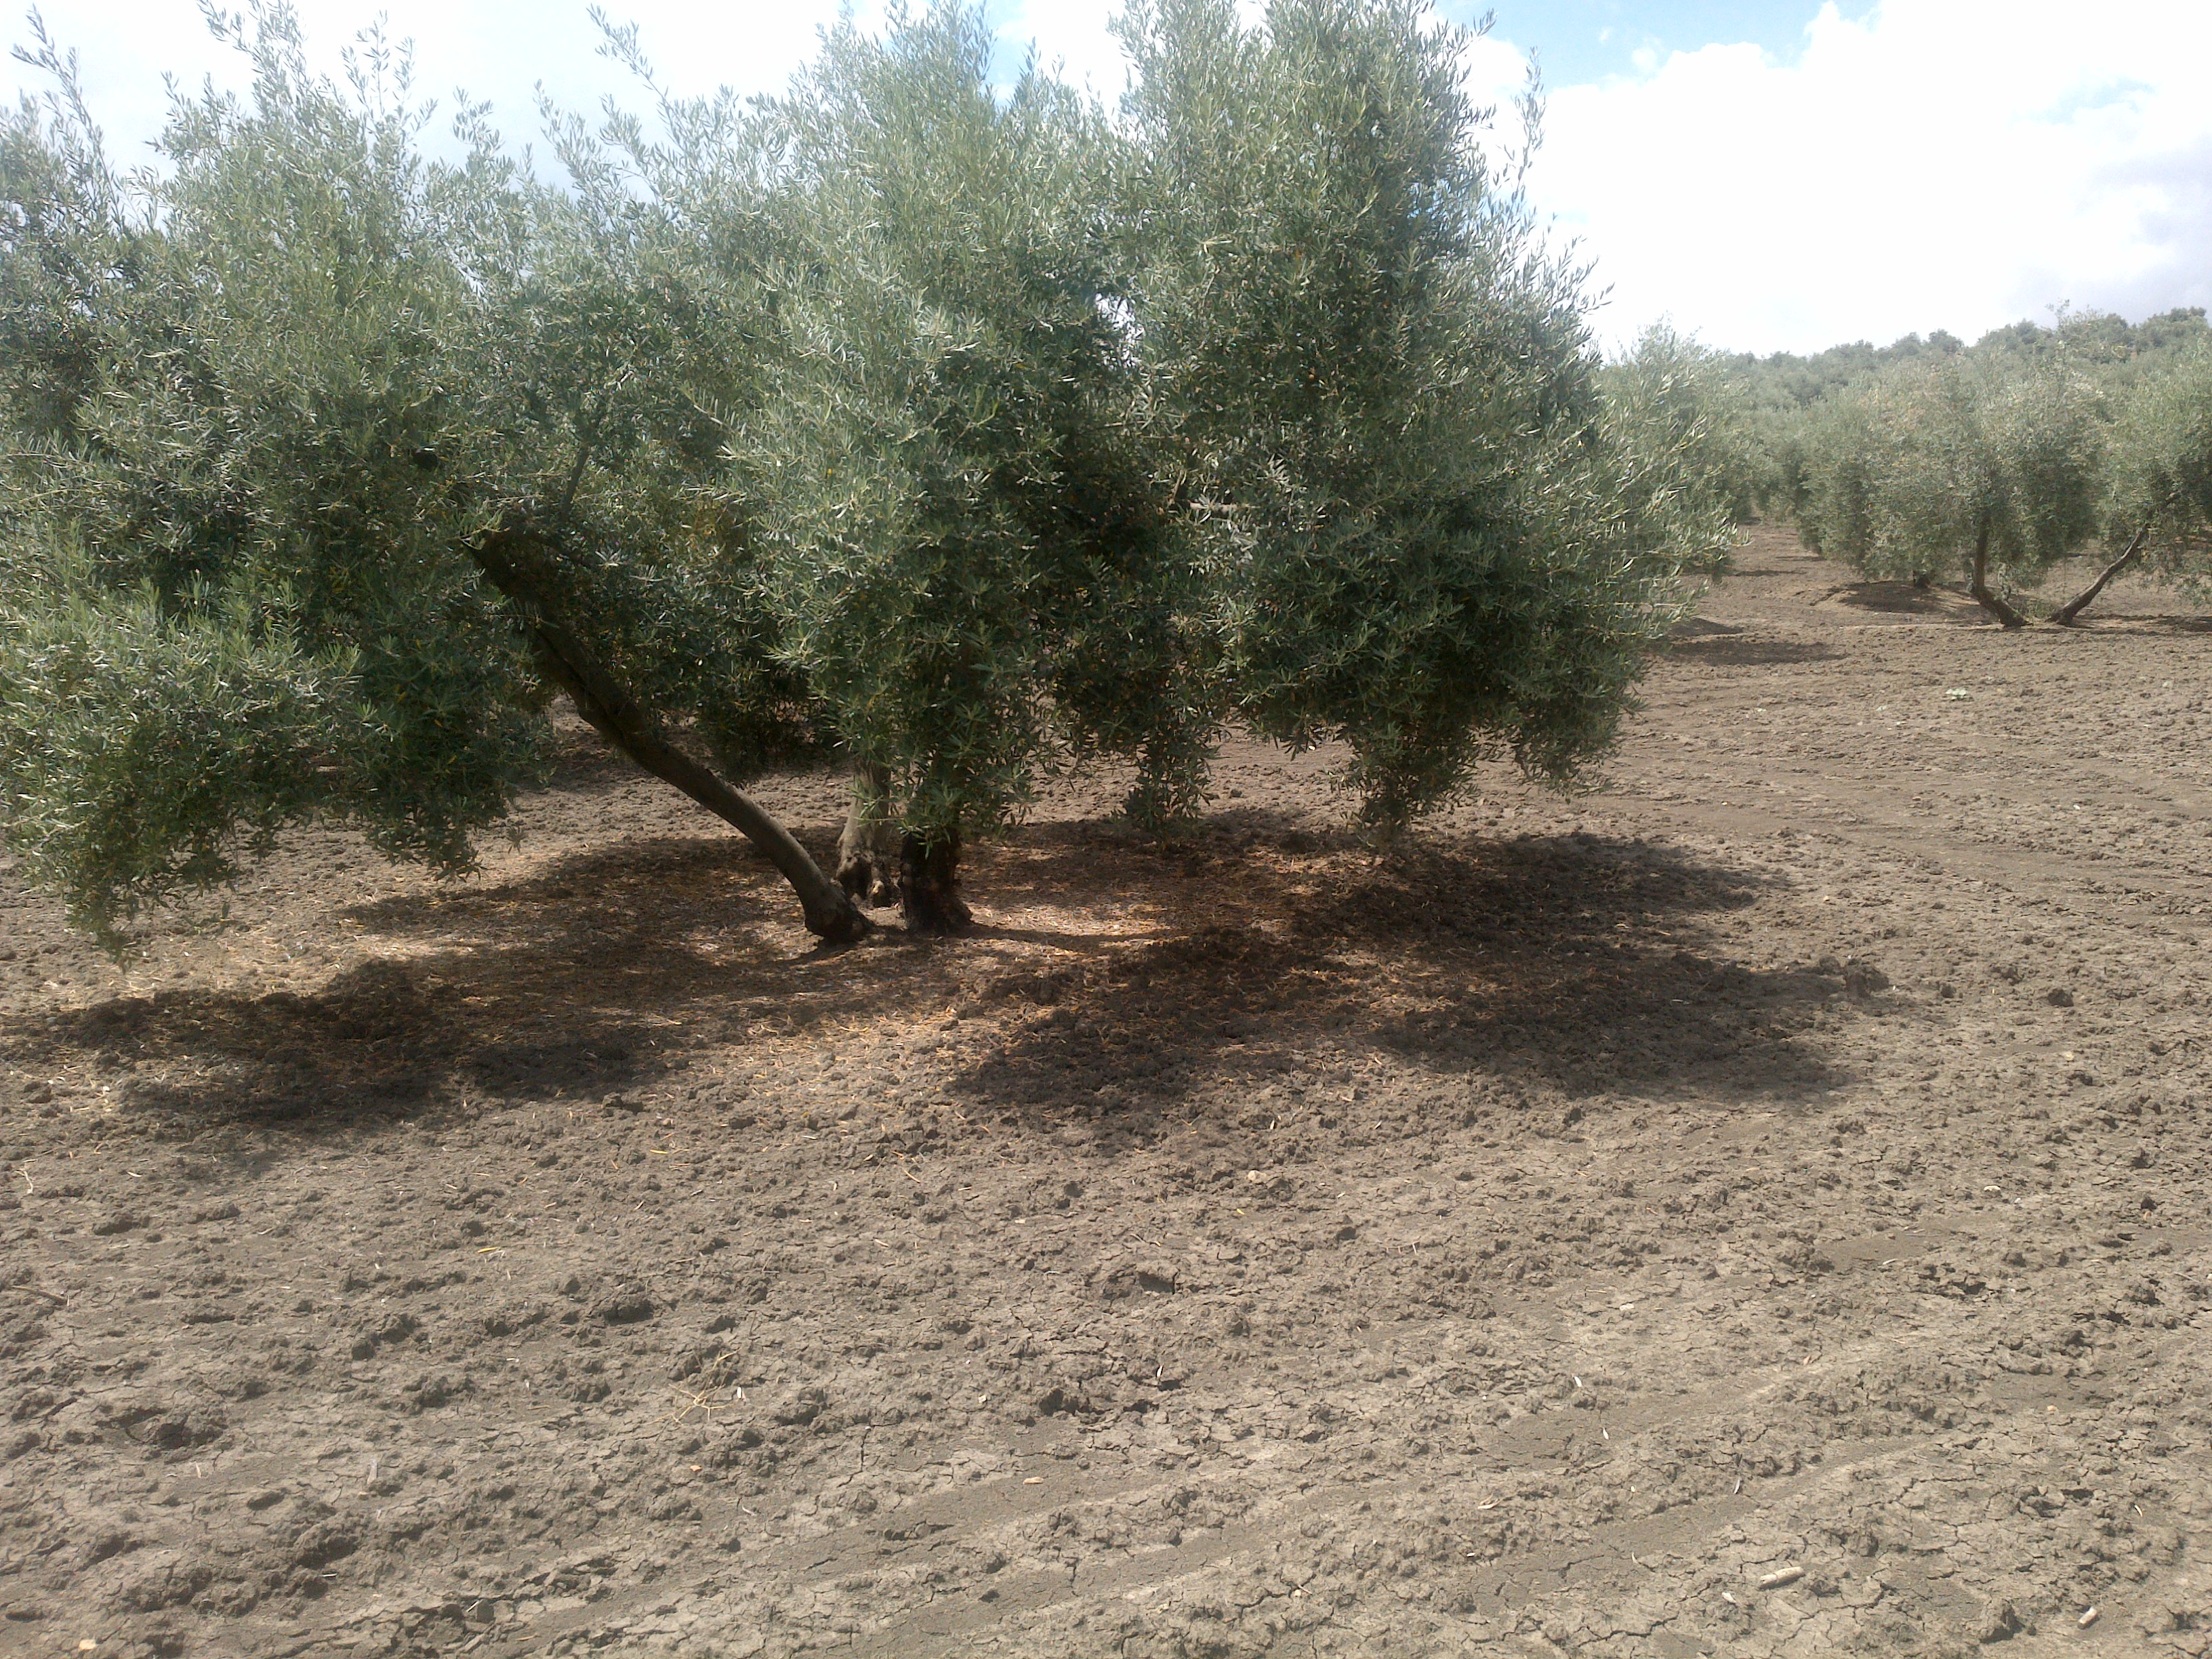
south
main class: Cropland
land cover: Olive groves
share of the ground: 50 - 75 %
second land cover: Other bare soil
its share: > 75 %
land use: Agriculture (excluding fallow land and kitchen gardens)
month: June
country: ES
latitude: 37.8596
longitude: -4.2722
